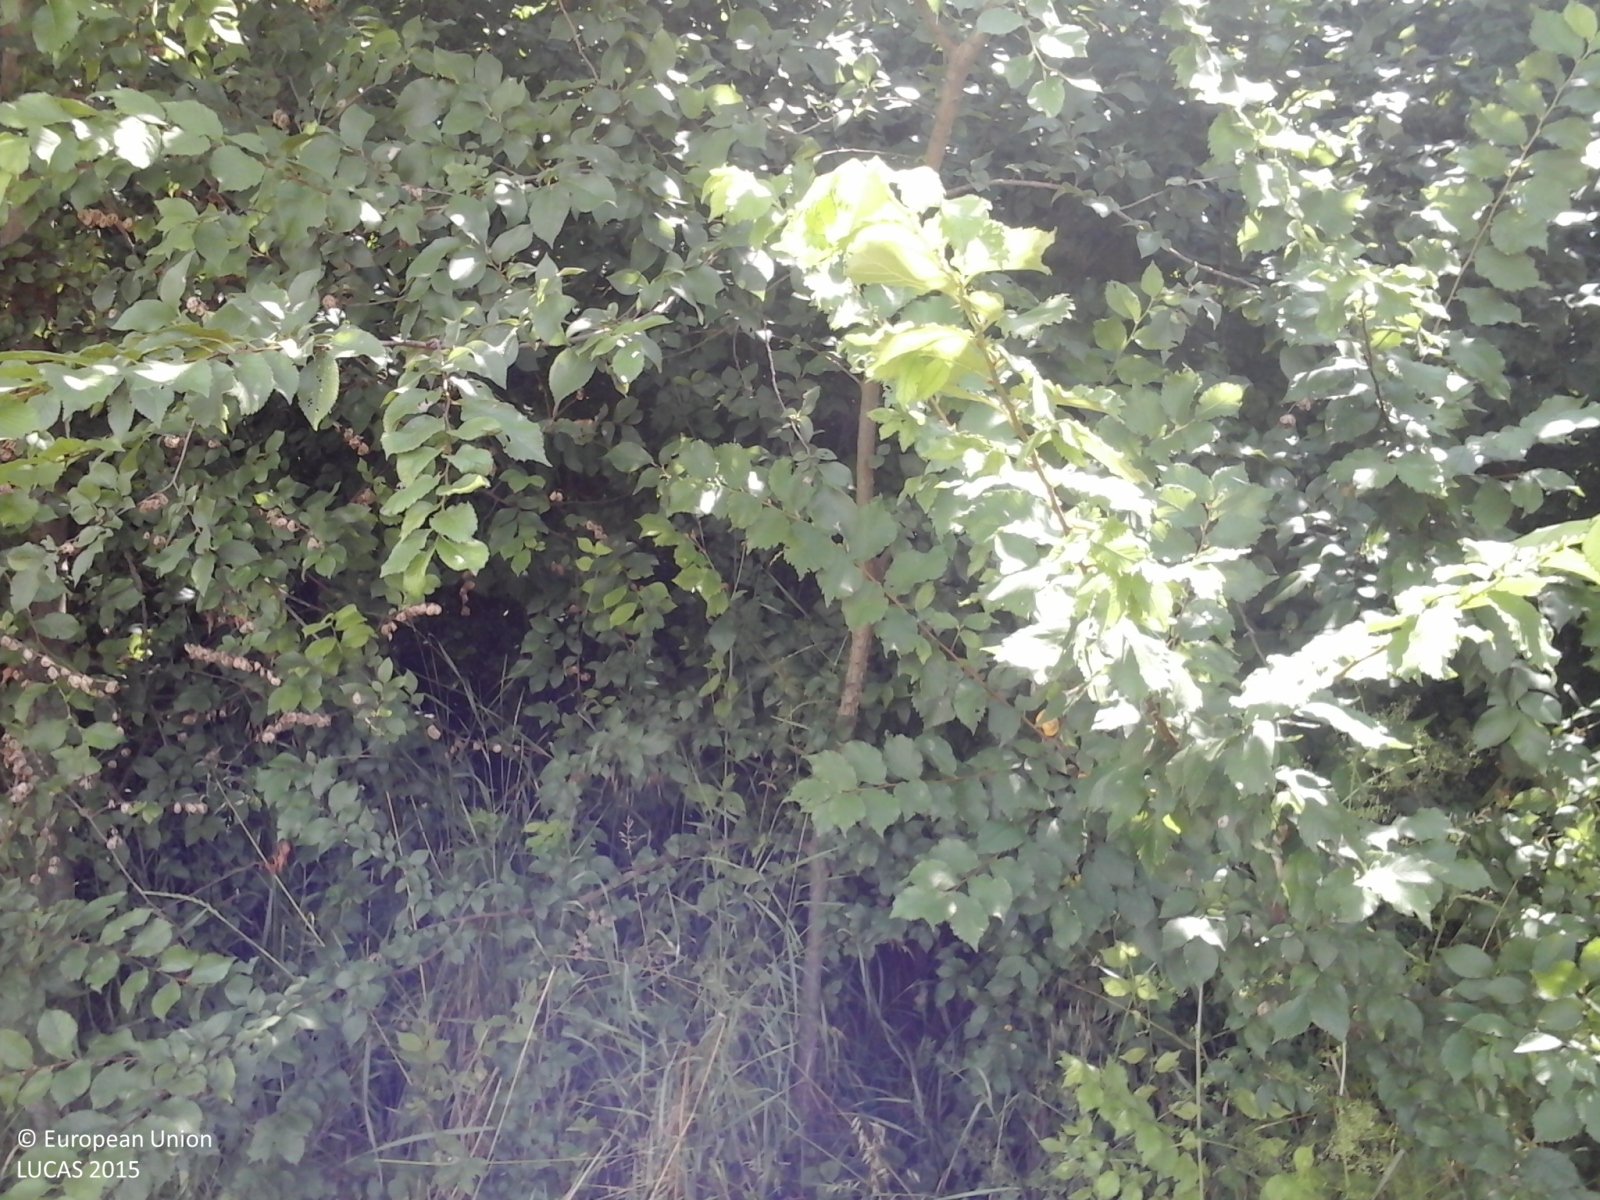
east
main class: Cropland
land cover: Common wheat
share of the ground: > 75 %
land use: Agriculture (excluding fallow land and kitchen gardens)
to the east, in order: Common wheat; Broadleaved woodland; Grassland without tree/shrub cover; Ditches and canals; Grass margins; Common wheat; Artificial constructions in urban areas
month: June
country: IT
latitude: 44.6697
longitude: 11.0699
